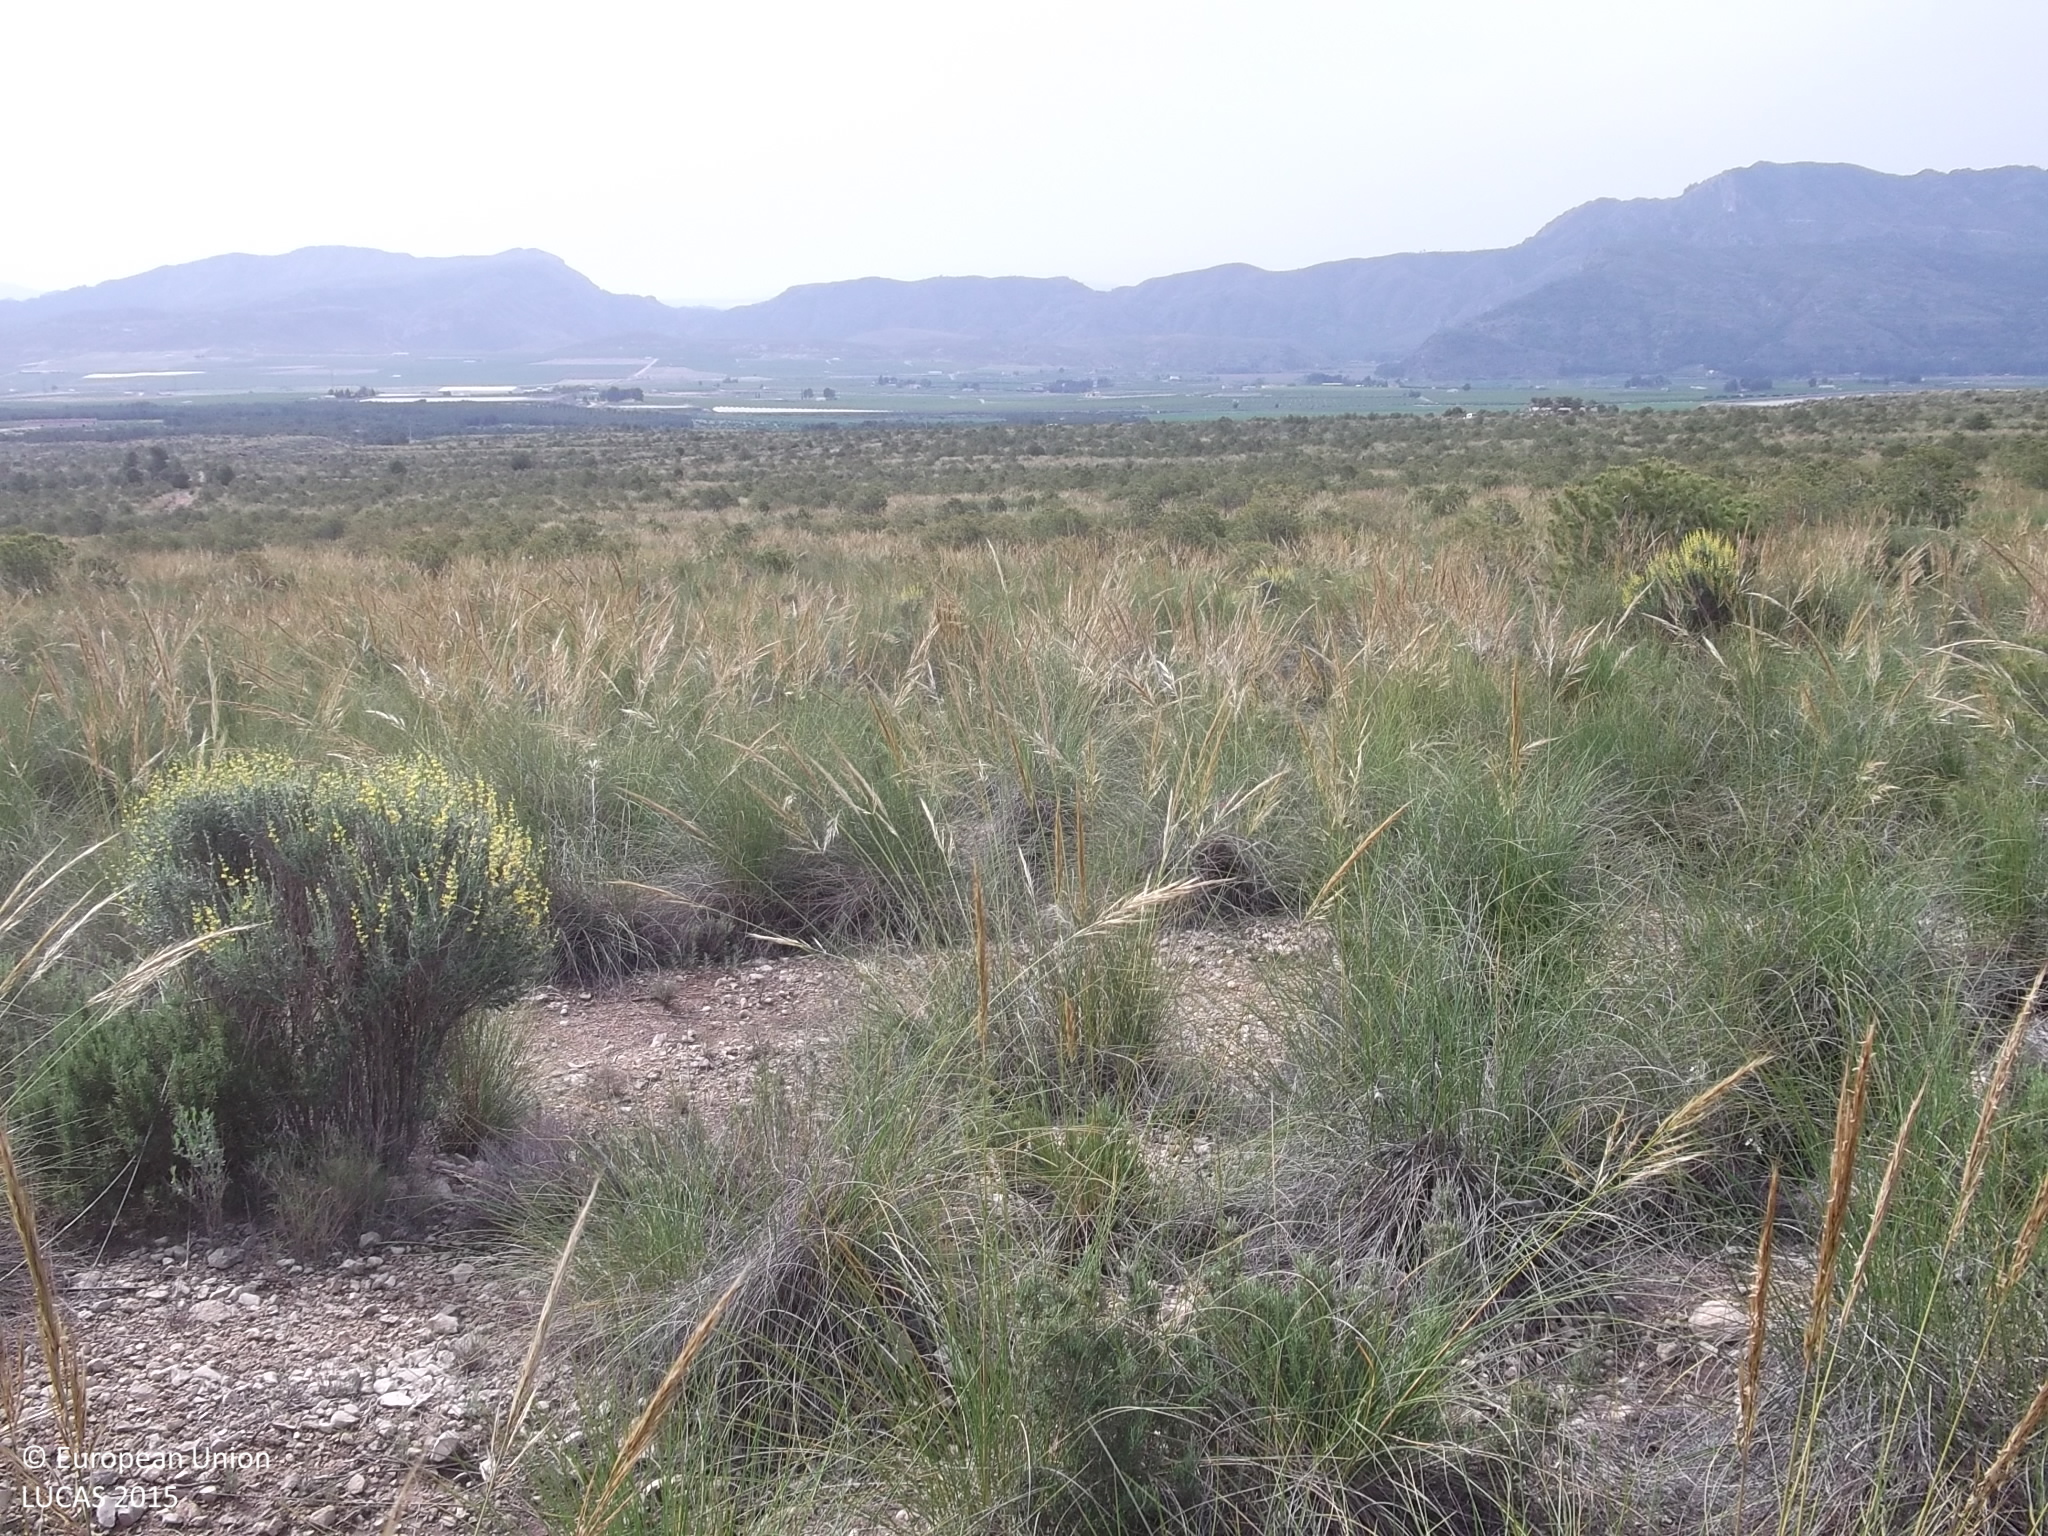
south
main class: Woodland
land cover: Pine dominated coniferous woodland
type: coniferous forest of the mediterranean region
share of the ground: 10 - 25 %
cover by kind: shrubs 65 %, consolidated bare surface 20 %, coniferous forest trees 15 %
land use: Semi-natural and natural areas not in use
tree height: < 5 m
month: April
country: ES
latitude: 38.2953
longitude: -1.6186
